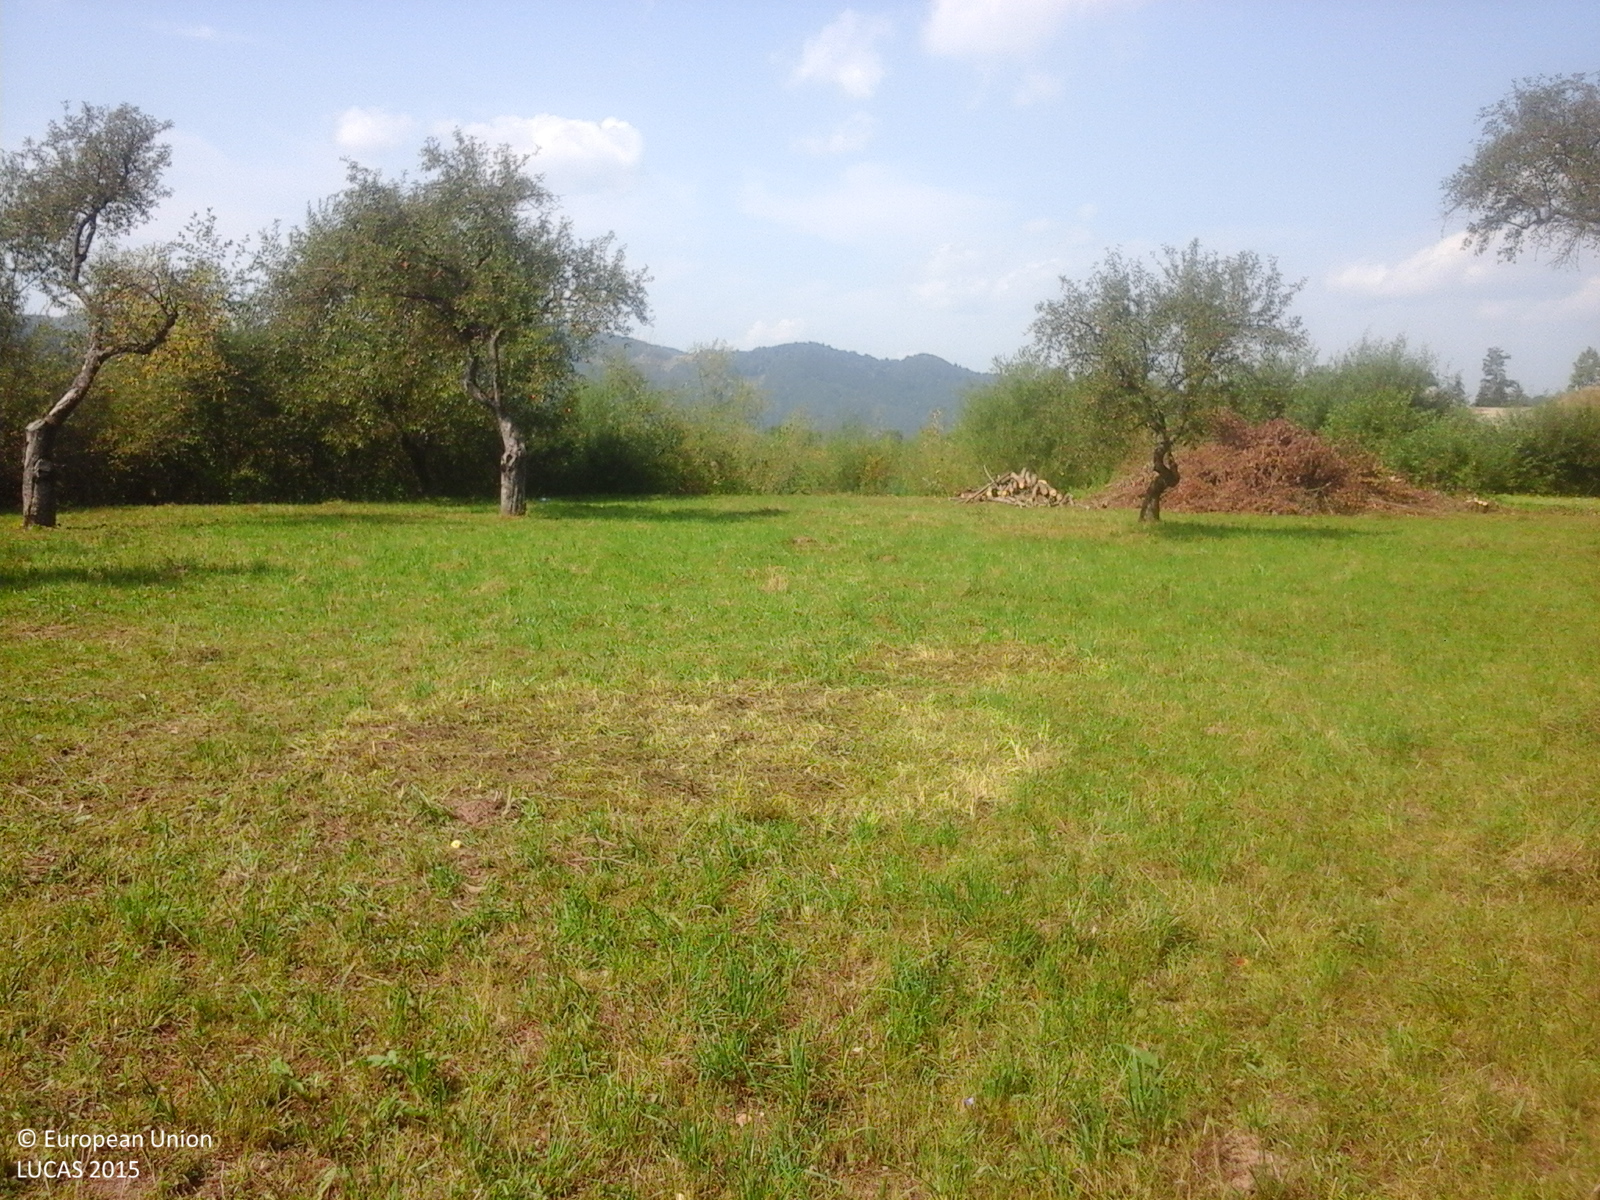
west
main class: Grassland
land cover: Grassland without tree/shrub cover
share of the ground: > 75 %
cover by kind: herbaceous plants 100 %
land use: Agriculture (excluding fallow land and kitchen gardens)
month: September
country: RO
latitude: 47.7814
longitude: 24.2779
